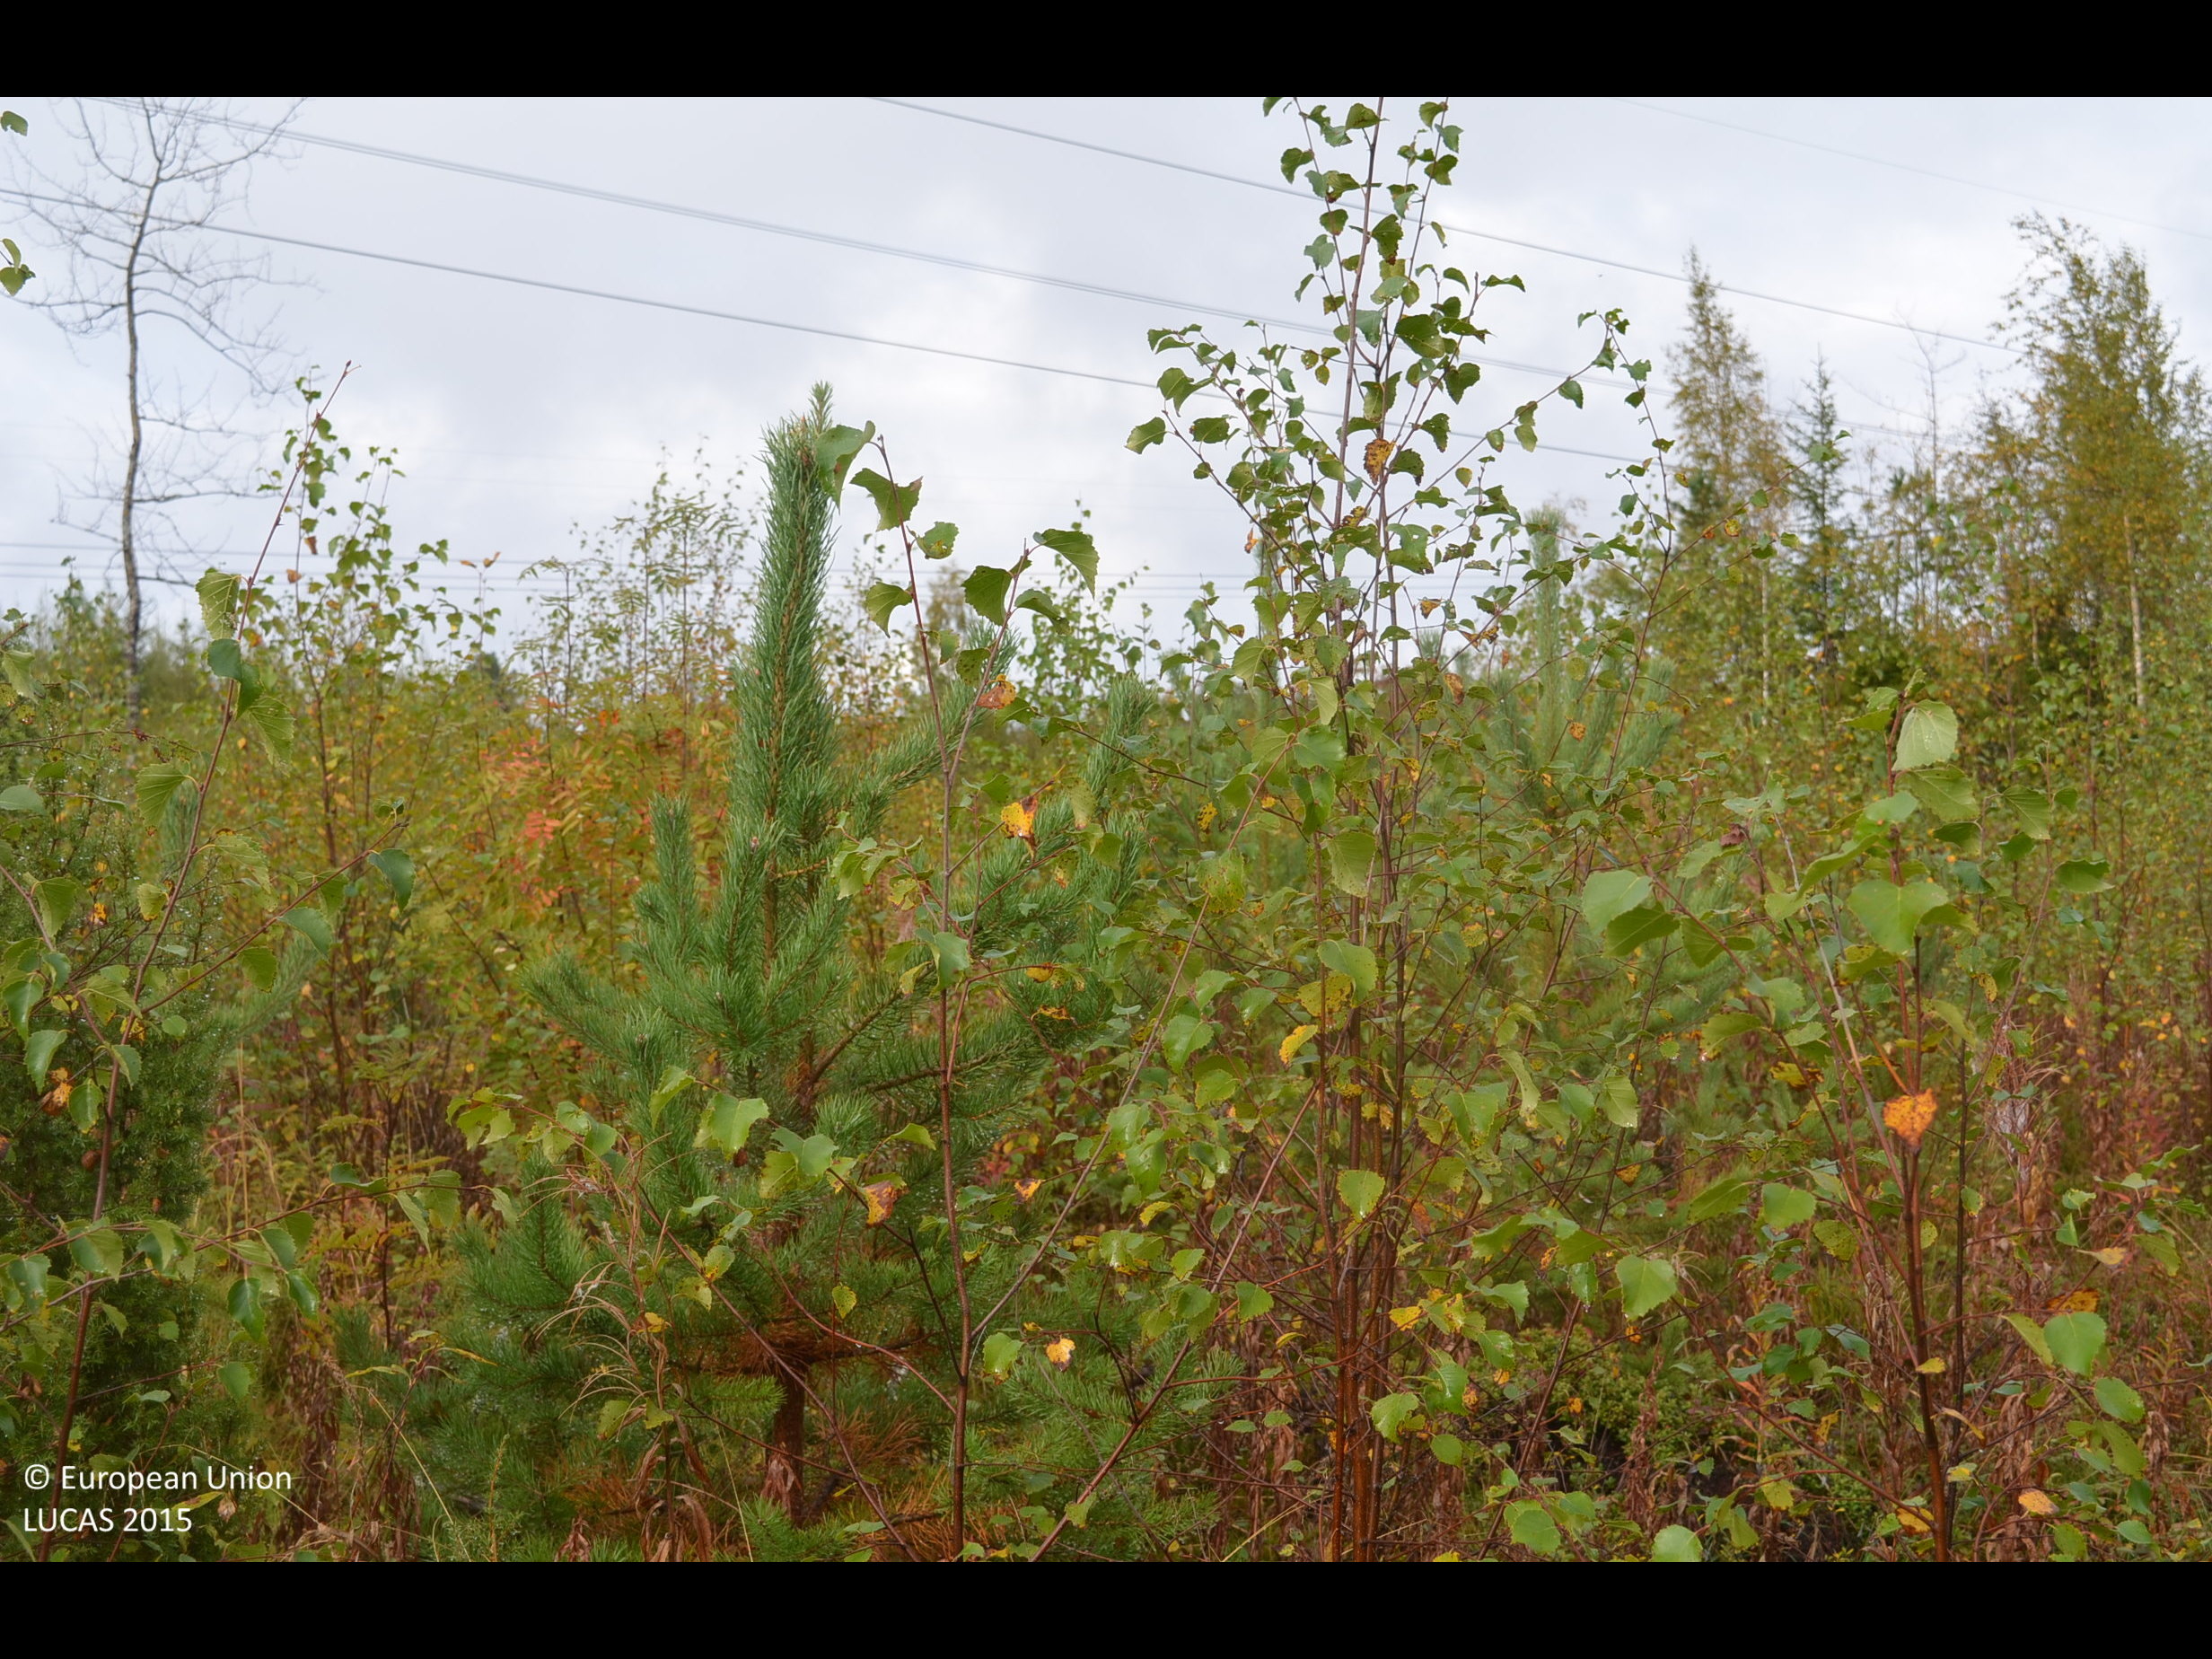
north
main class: Woodland
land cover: Pine dominated mixed woodland
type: boreal forest
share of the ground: 50 - 75 %
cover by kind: broadleaved forest trees 40 %, coniferous forest trees 30 %, herbaceous plants 15 %, shrubs 10 %, lichens and mosses 5 %
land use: Forestry
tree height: < 5 m
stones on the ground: < 10 %
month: September
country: FI
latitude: 62.9735
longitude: 23.9016
